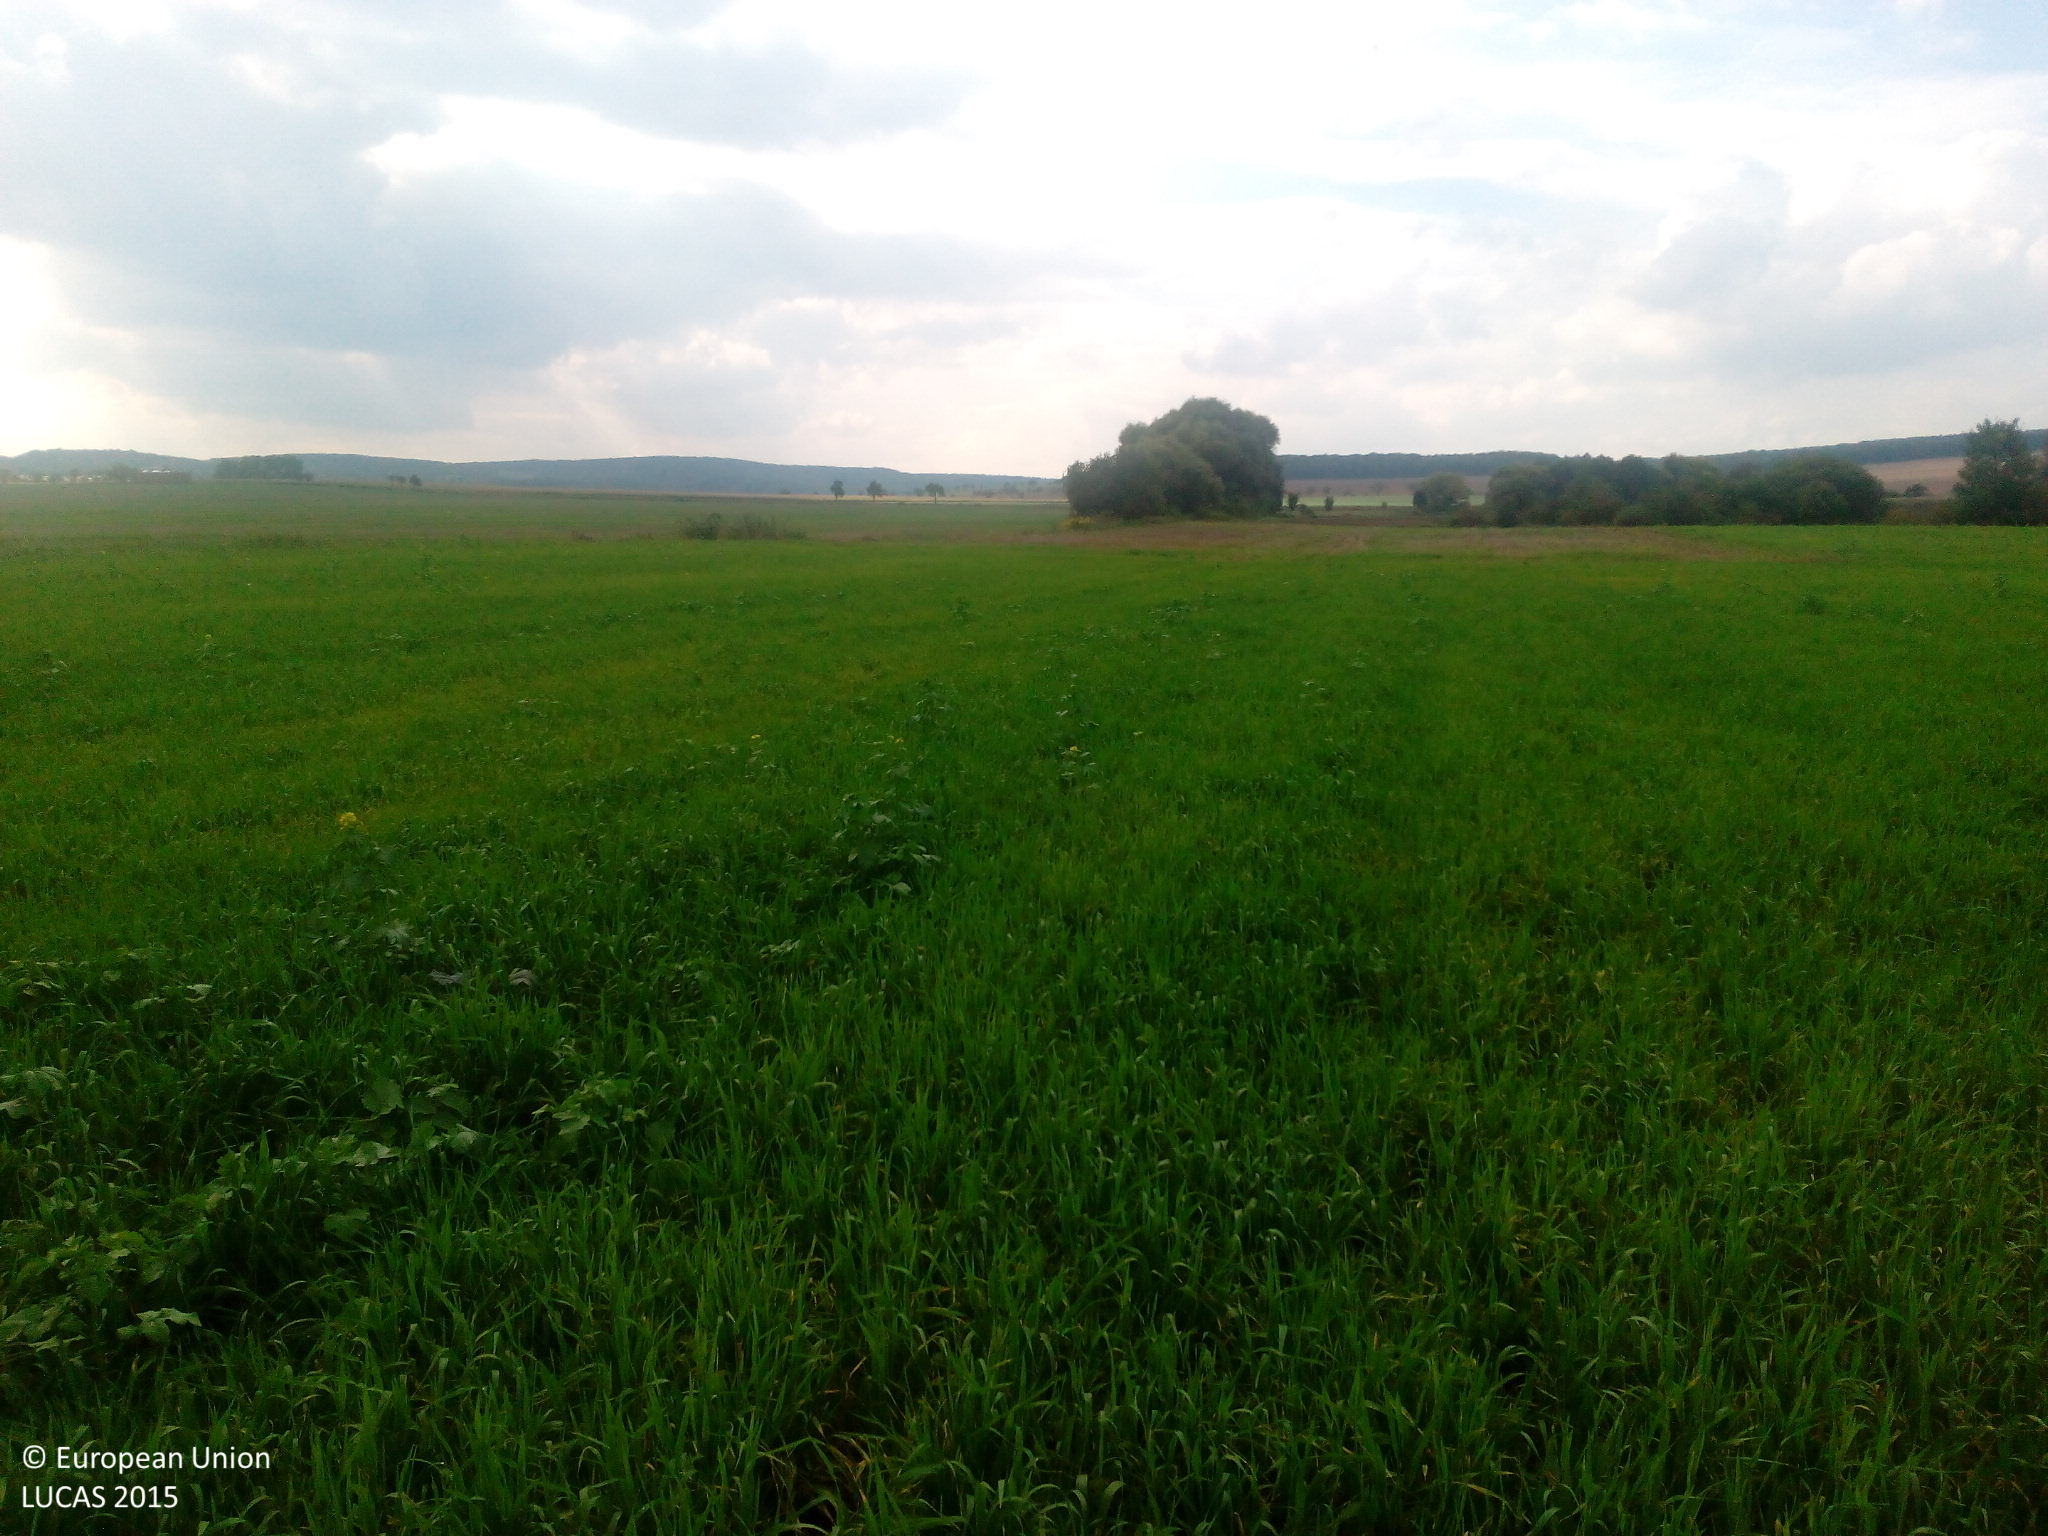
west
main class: Cropland
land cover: Temporary grasslands
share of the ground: > 75 %
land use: Agriculture (excluding fallow land and kitchen gardens)
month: September
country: DE
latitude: 51.3844
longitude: 11.0199
